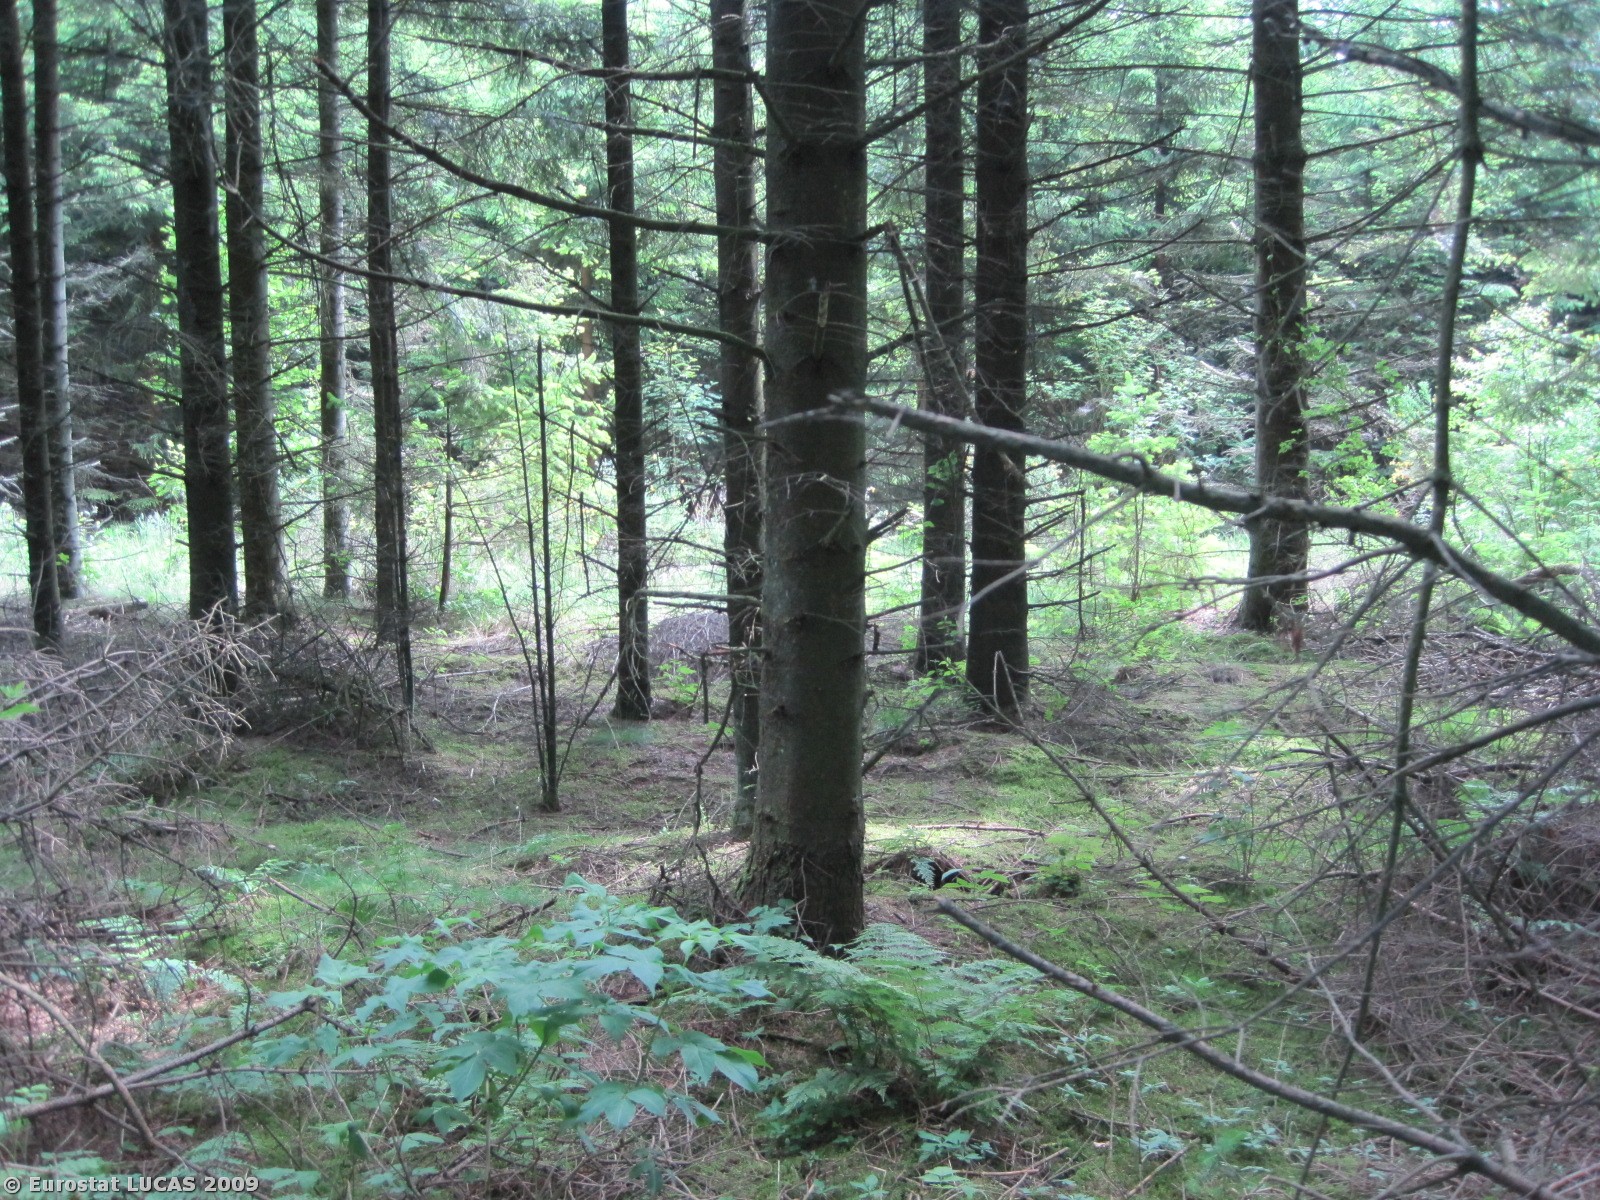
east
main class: Woodland
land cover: Coniferous woodland
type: plantations and self-sown exotic forest
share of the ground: 50 - 75 %
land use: Forestry
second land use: Amenities, museums, leisure
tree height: > 5 m
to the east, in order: Coniferous woodland; Grass margins; Tracks; Grass margins; Coniferous woodland; Tracks; Coniferous woodland; Tracks; Coniferous woodland; Tracks; Mixed woodland; Grassland without tree/shrub cover; Coniferous woodland
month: June
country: DK
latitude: 57.1942
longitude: 10.2478
